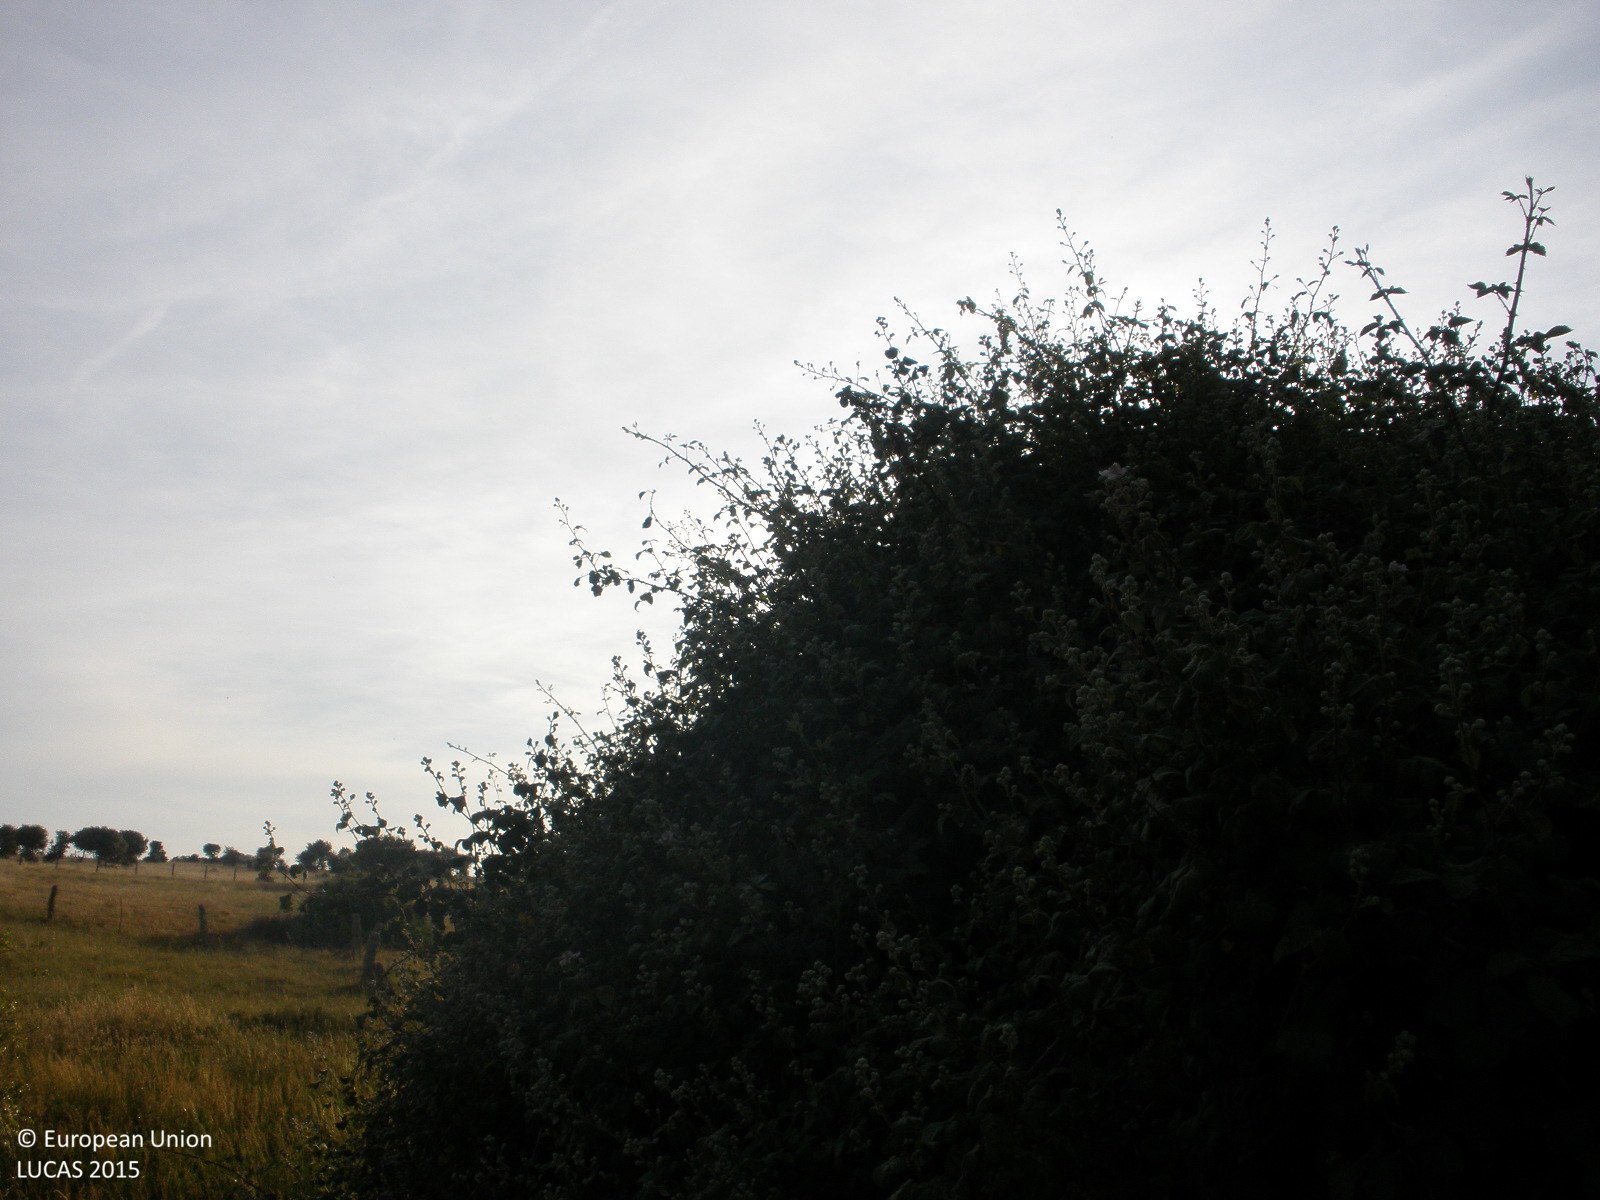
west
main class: Shrubland
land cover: Shrubland with sparse tree cover
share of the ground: > 75 %
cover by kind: shrubs 95 %, broadleaved forest trees 5 %
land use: Agriculture (excluding fallow land and kitchen gardens)
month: June
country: ES
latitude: 40.6389
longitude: -6.7557
